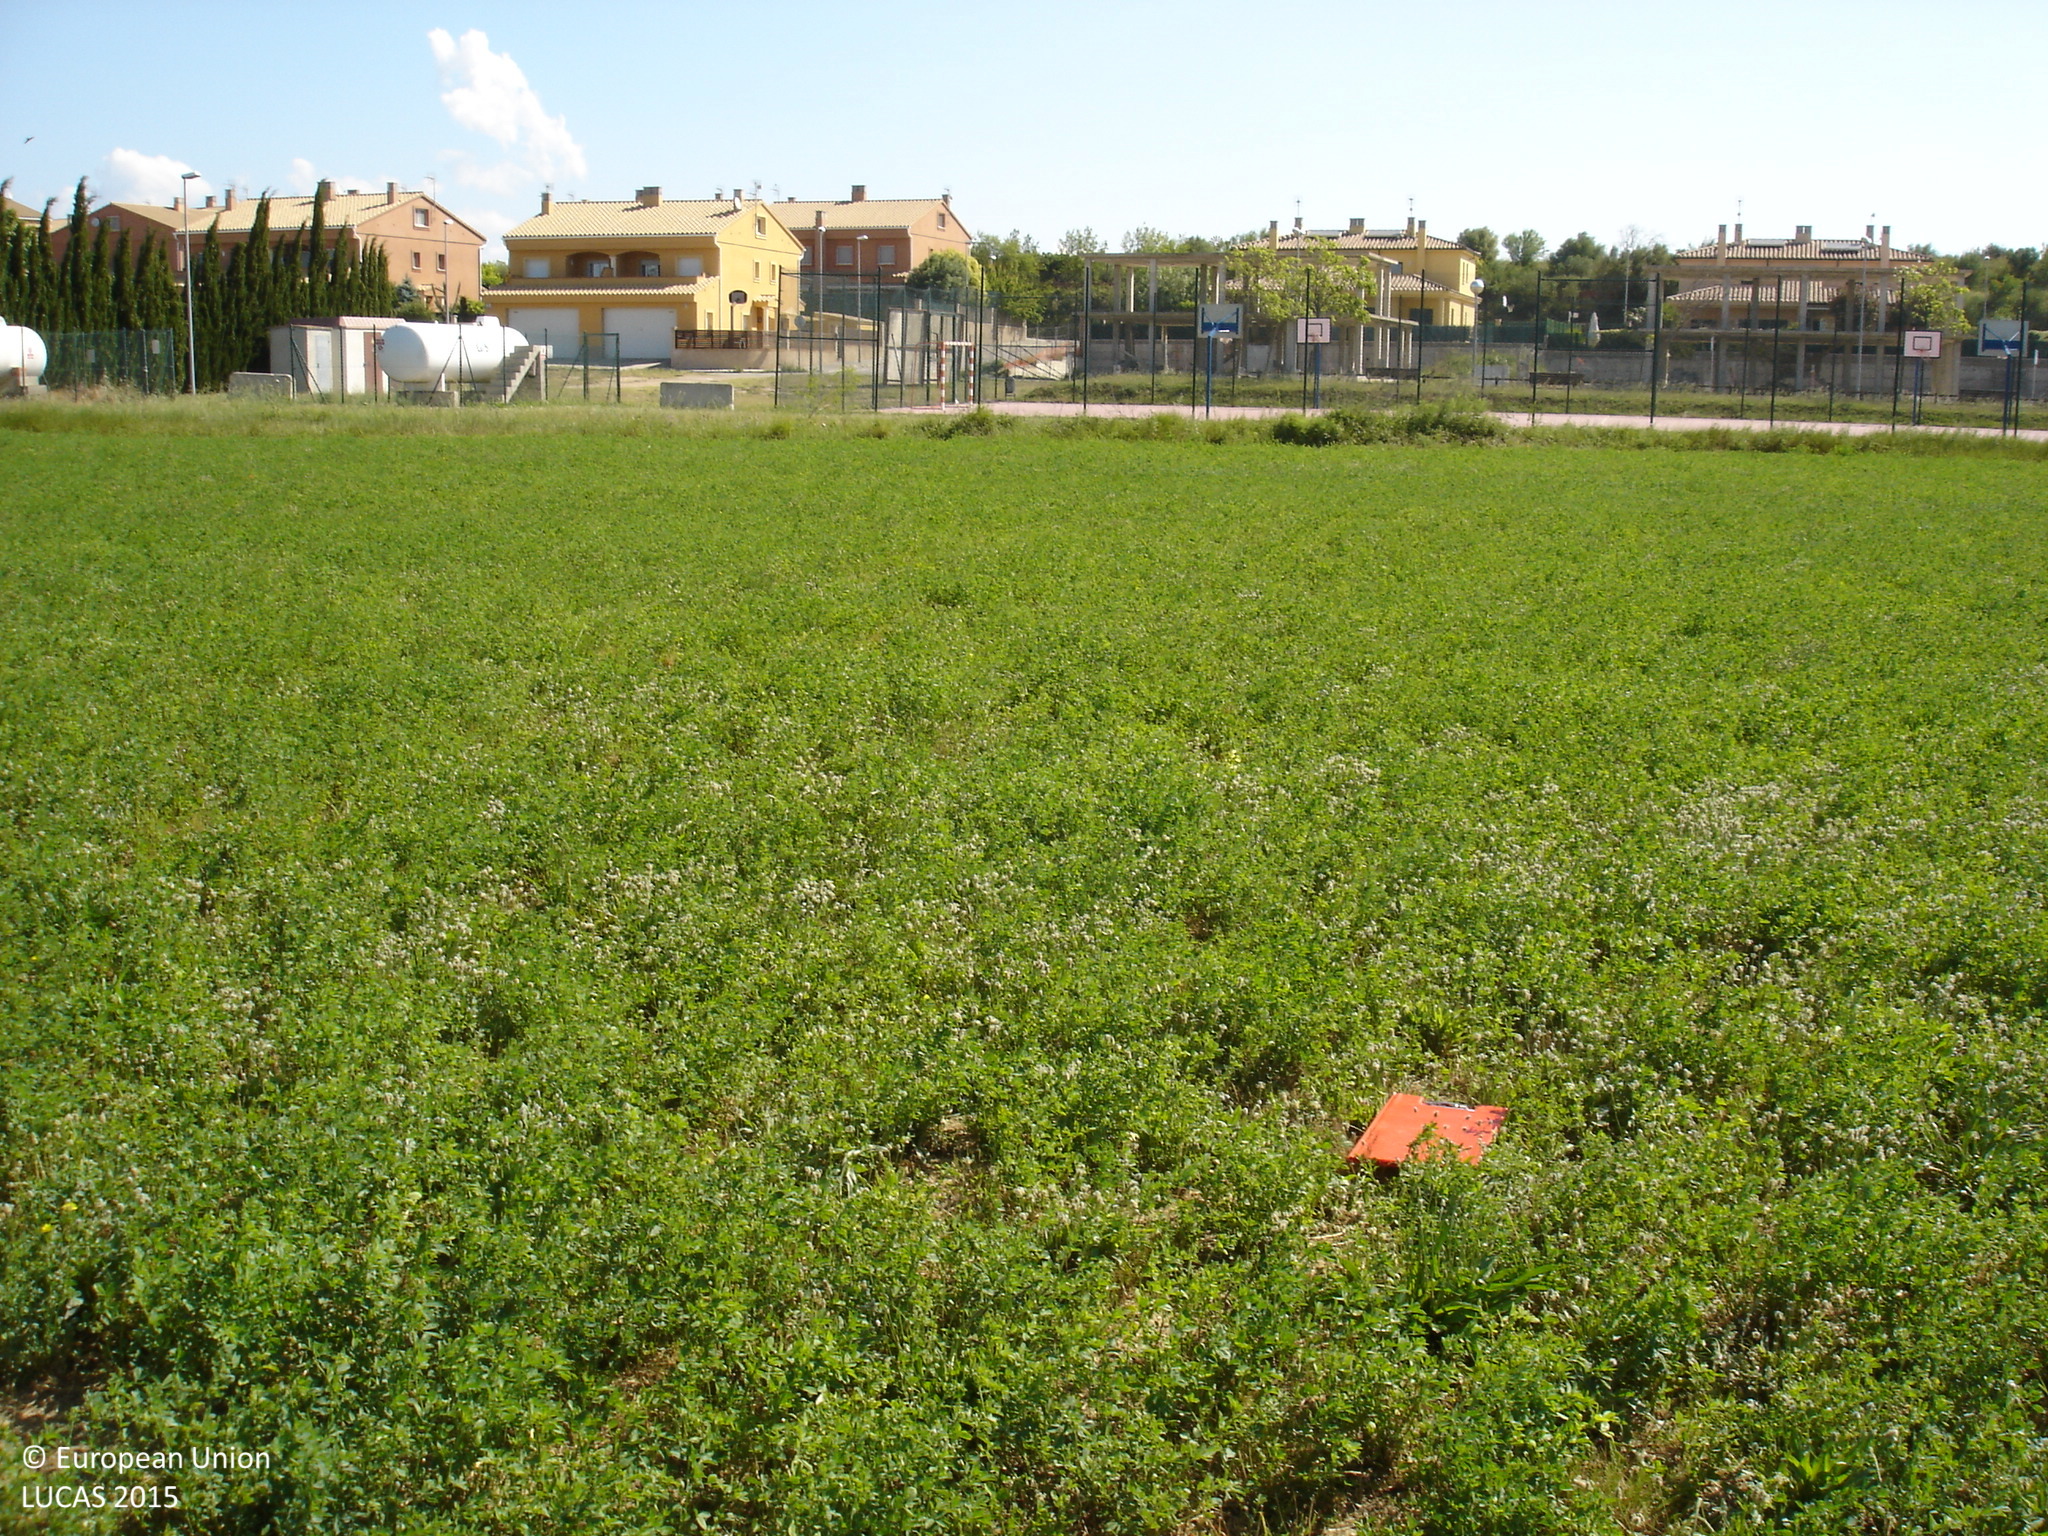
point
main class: Cropland
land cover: Lucerne
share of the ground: > 75 %
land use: Agriculture (excluding fallow land and kitchen gardens)
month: May
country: ES
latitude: 42.2484
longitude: 2.9969
